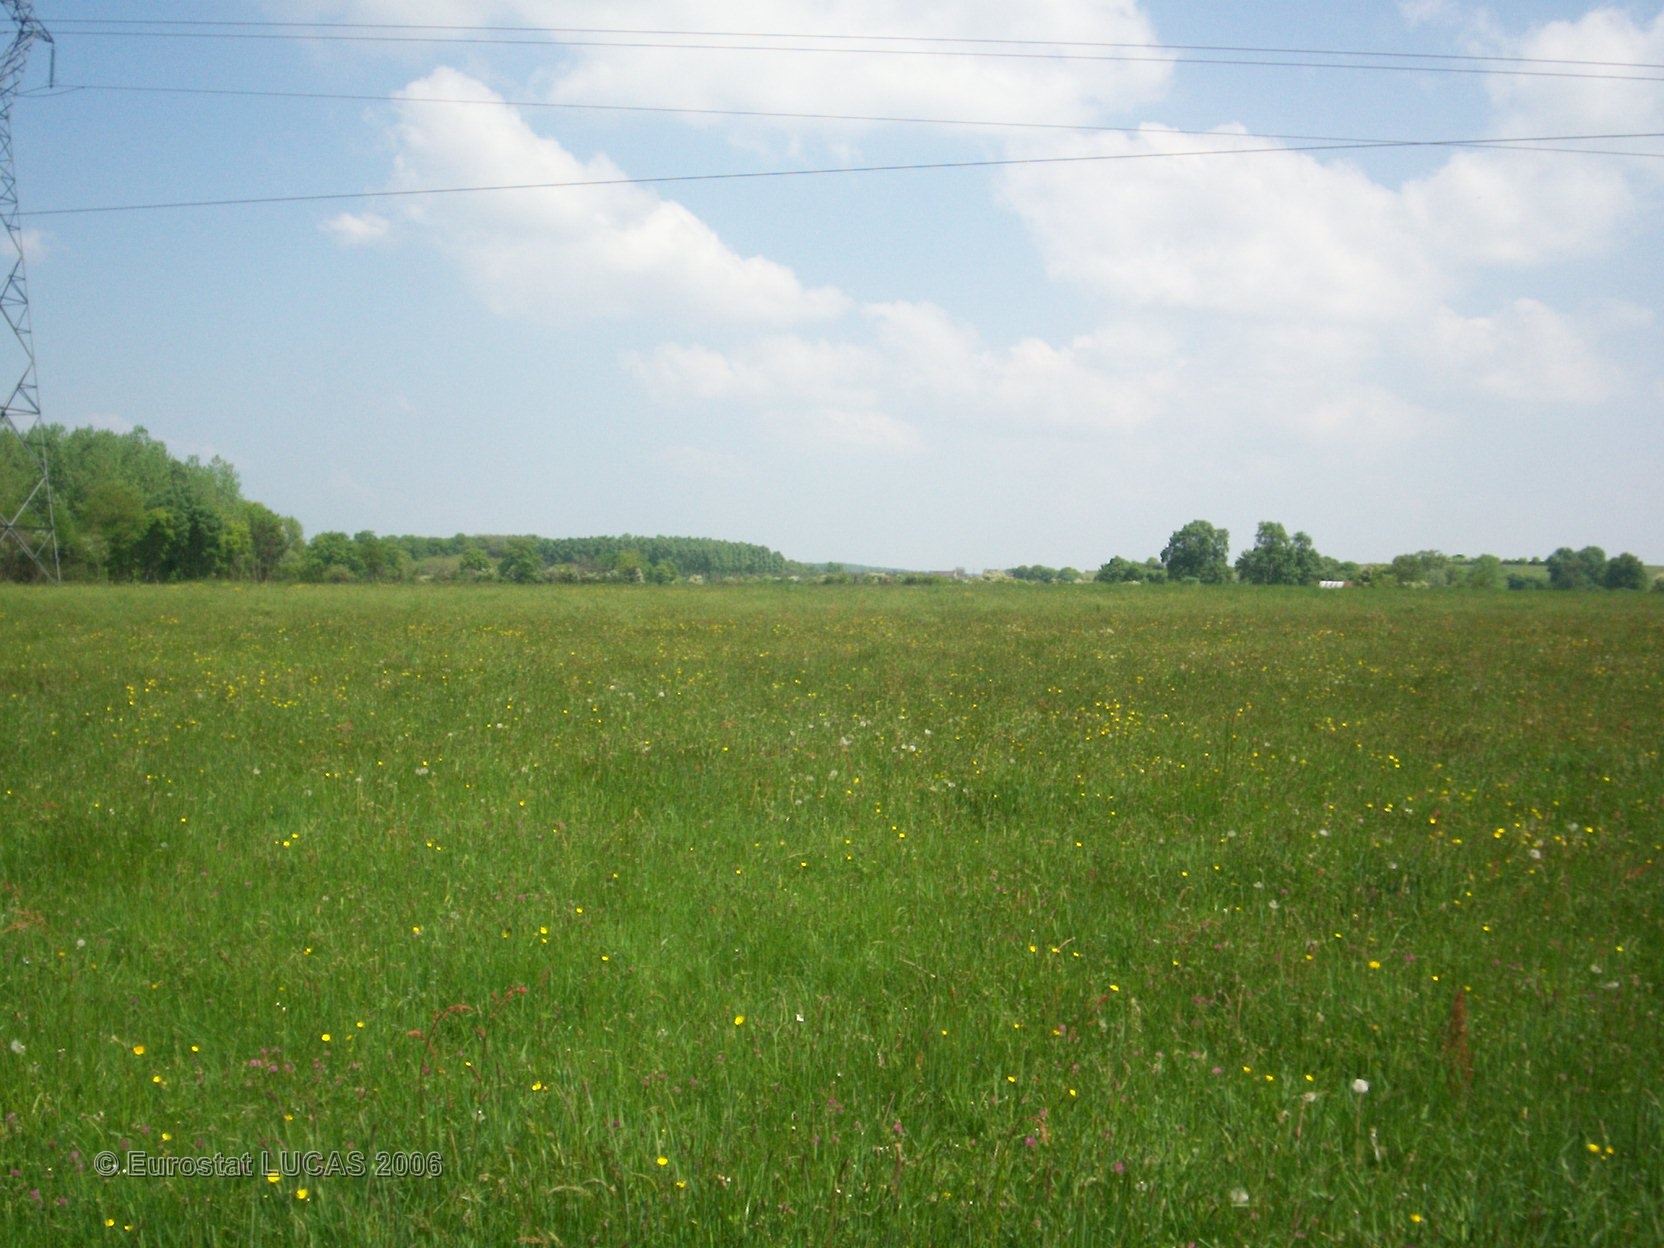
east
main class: Grassland
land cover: Grassland without tree/shrub cover
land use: Agriculture (excluding fallow land and kitchen gardens)
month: May
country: FR
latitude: 47.6960
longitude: 0.2082
